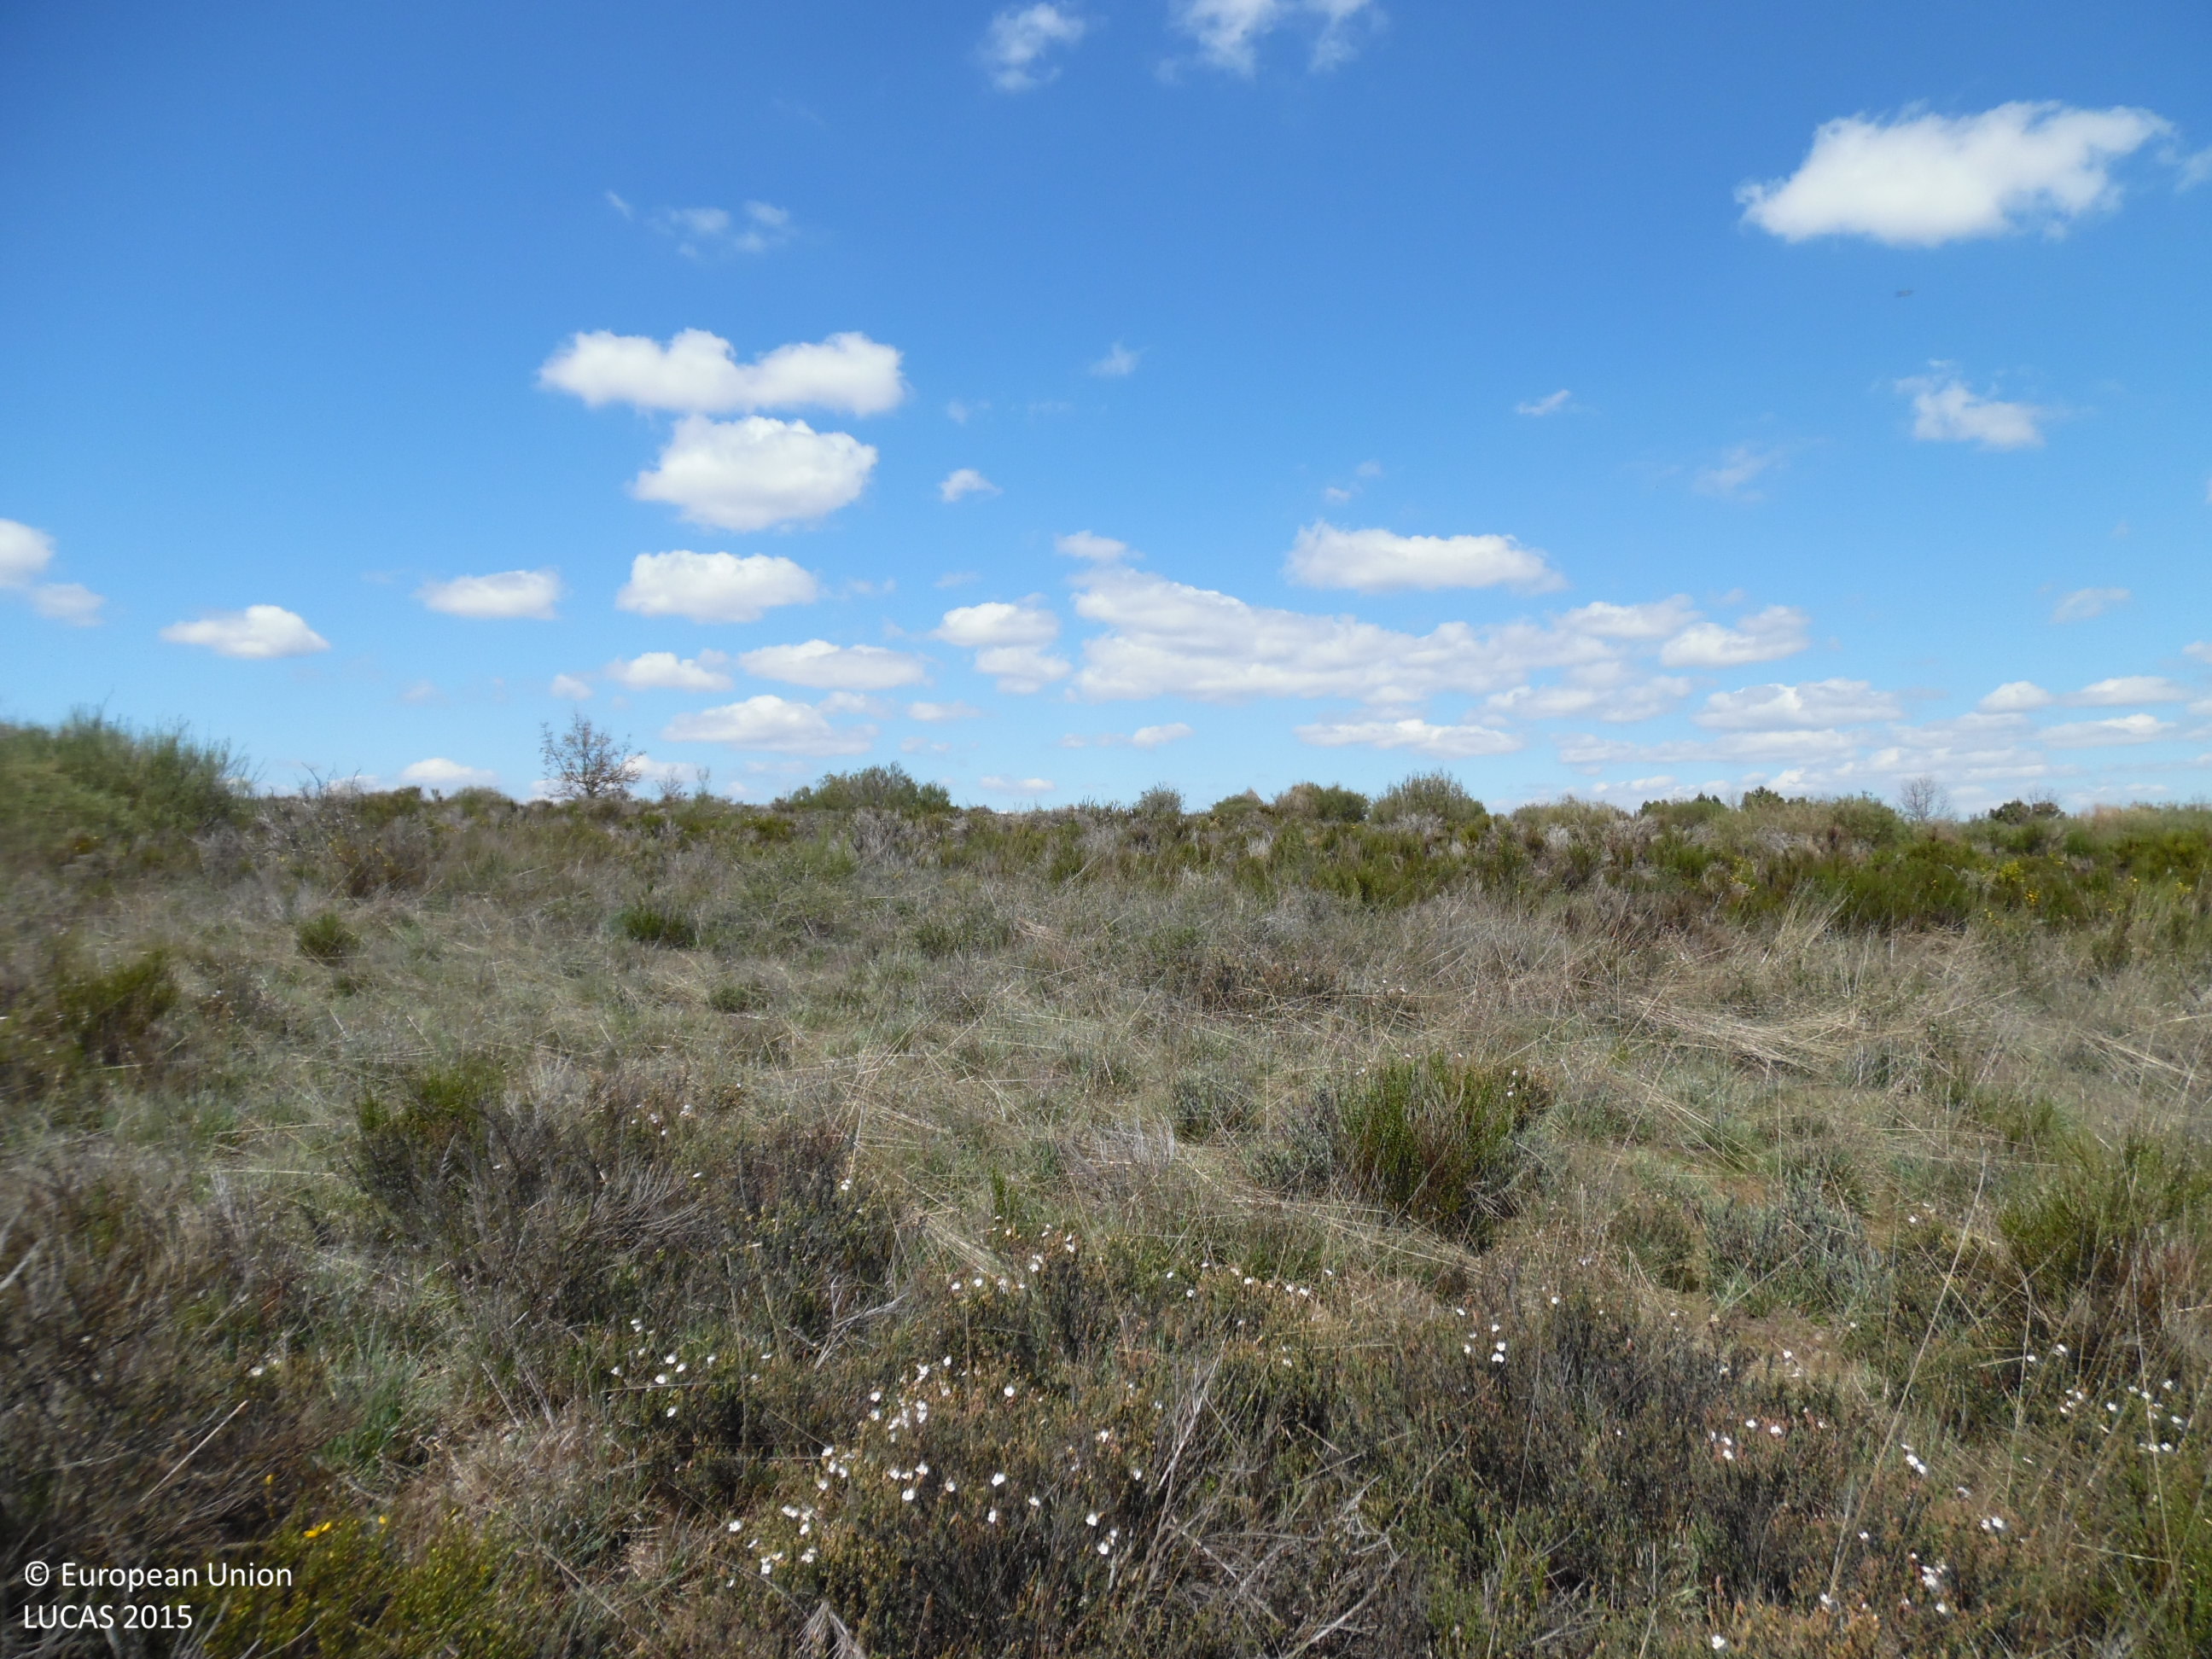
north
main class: Shrubland
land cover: Shrubland without tree cover
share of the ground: > 75 %
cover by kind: shrubs 95 %, herbaceous plants 5 %
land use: Abandoned areas
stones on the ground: 10 - 25 %
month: April
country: ES
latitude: 42.6016
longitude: -5.6636
